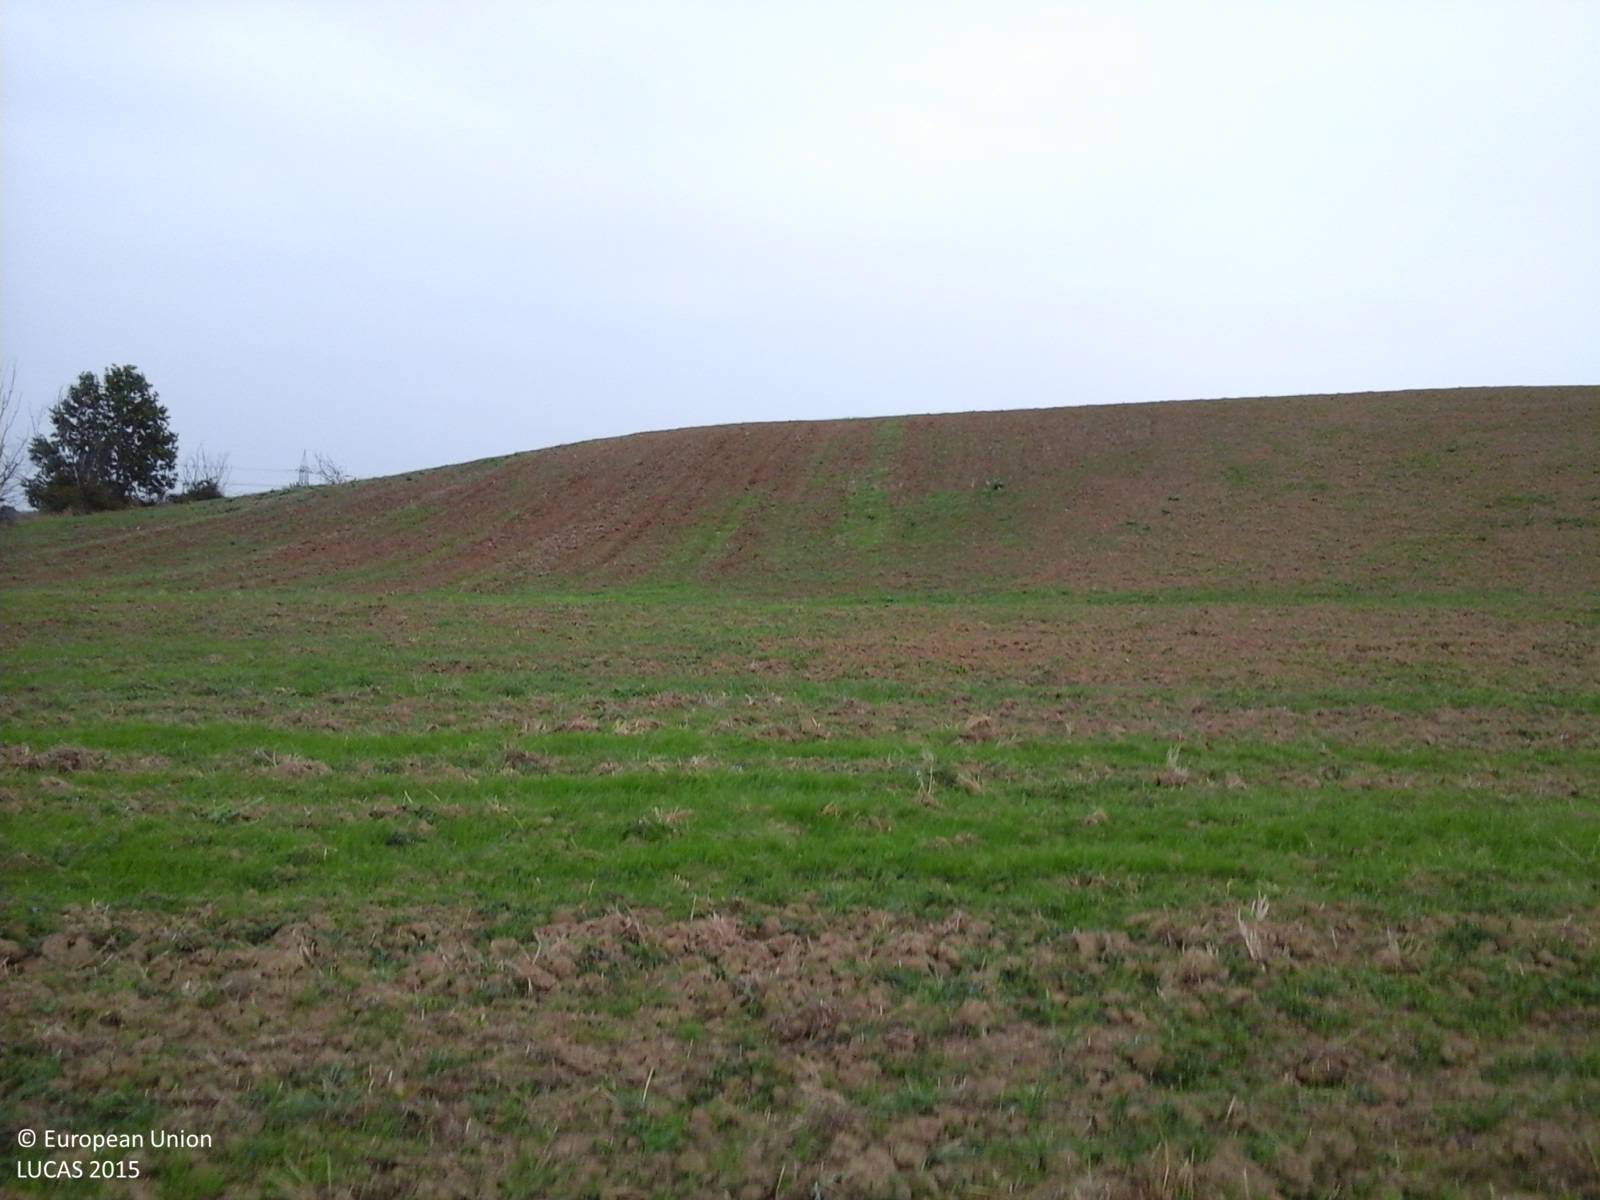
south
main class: Grassland
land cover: Grassland without tree/shrub cover
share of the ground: 25 - 50 %
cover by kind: herbaceous plants 100 %
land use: Agriculture (excluding fallow land and kitchen gardens)
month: October
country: IT
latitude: 43.5556
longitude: 10.4814
